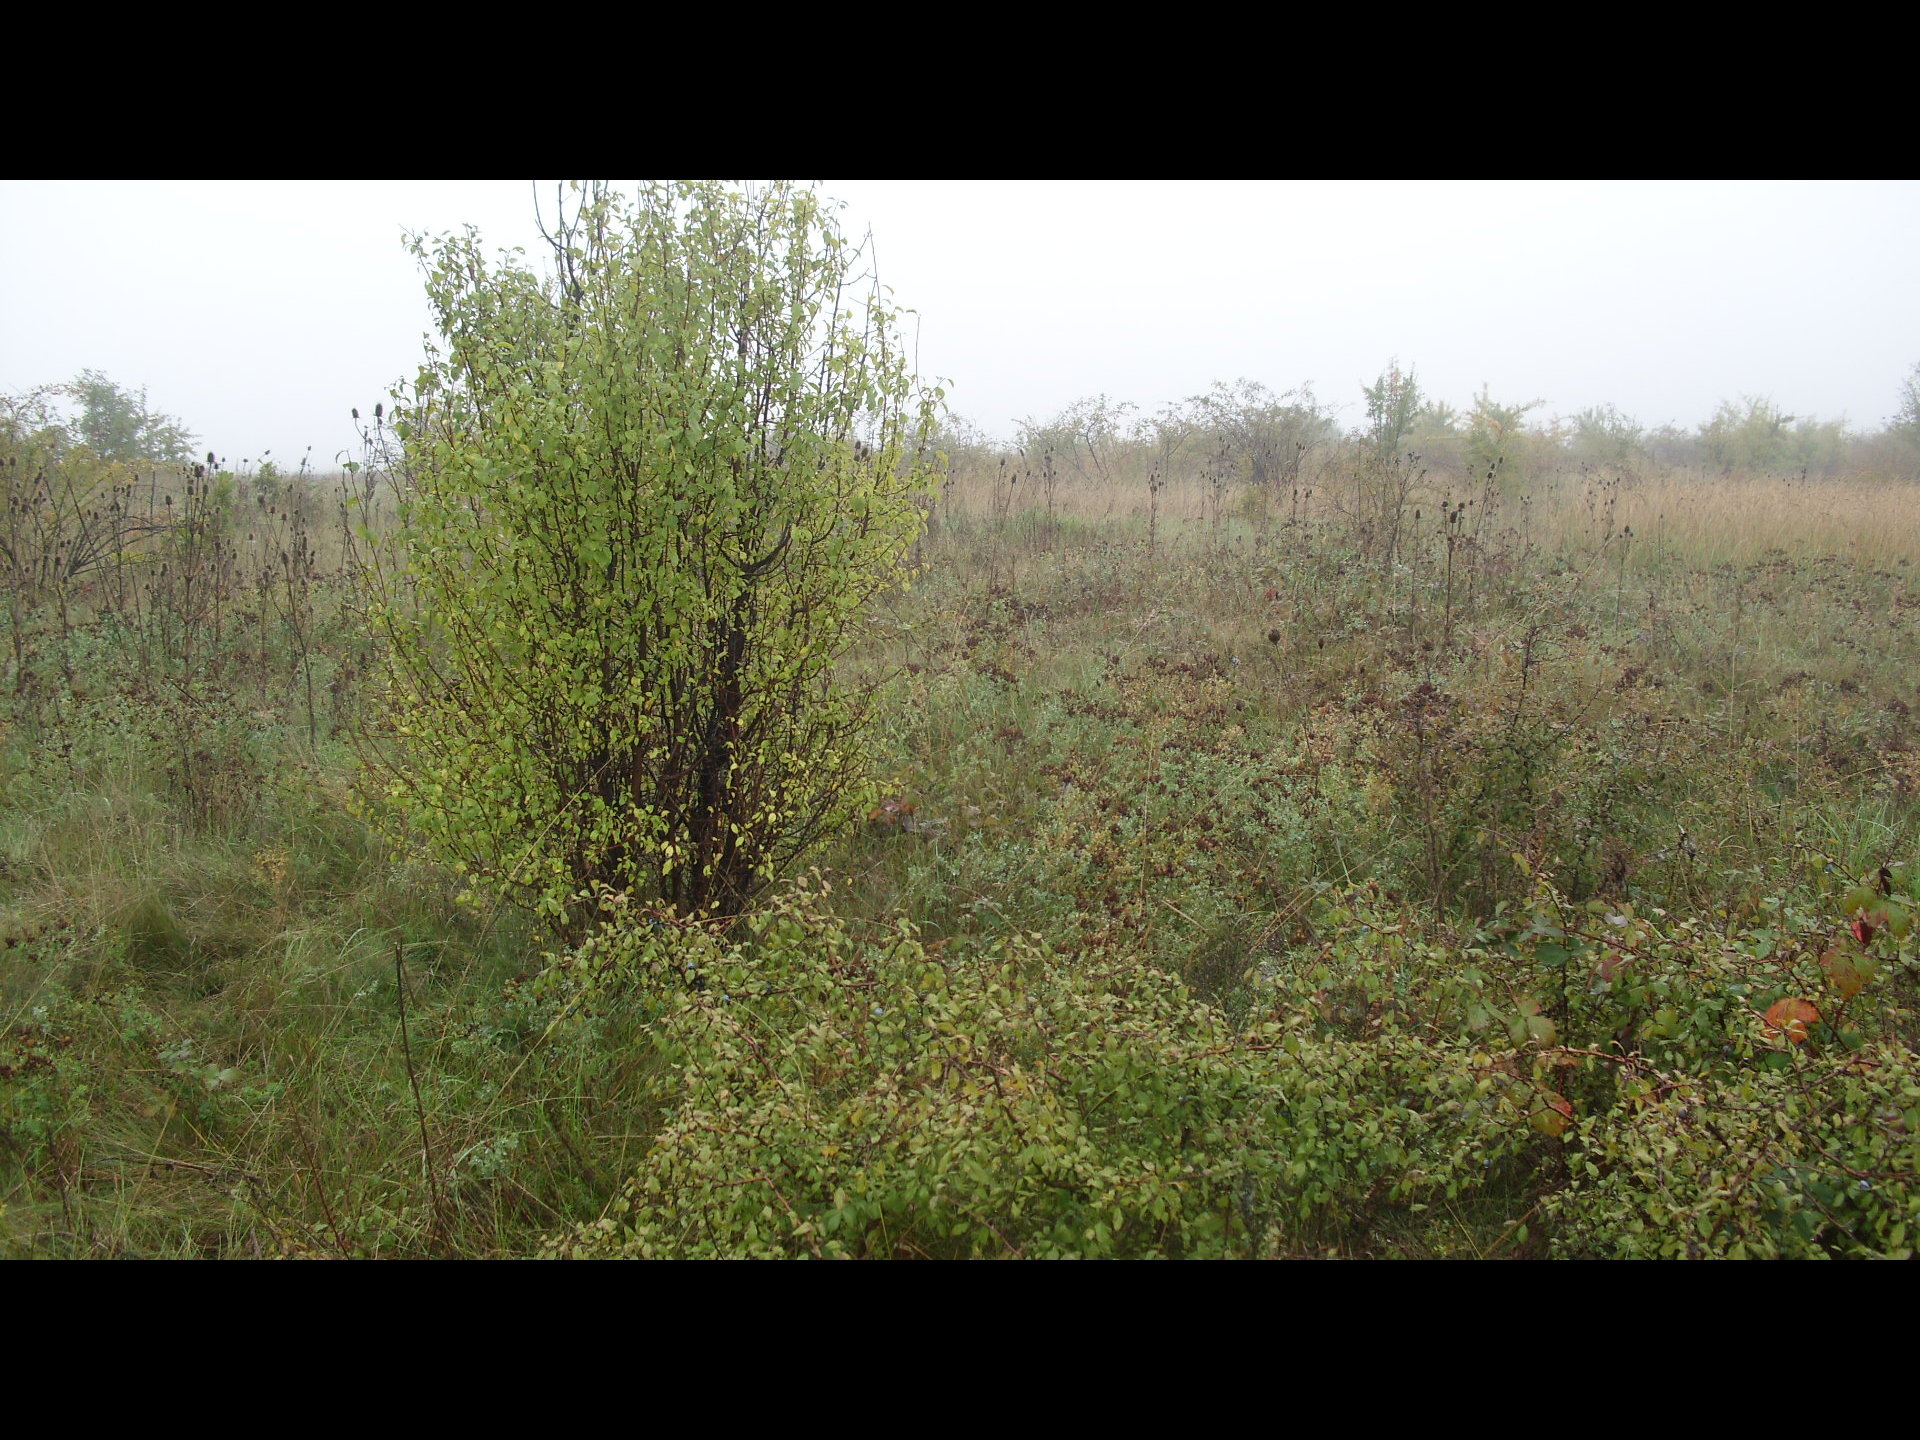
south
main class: Grassland
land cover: Grassland with sparse tree/shrub cover
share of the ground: > 75 %
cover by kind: herbaceous plants 85 %, shrubs 10 %, broadleaved forest trees 5 %
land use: Semi-natural and natural areas not in use
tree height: < 5 m
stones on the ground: < 10 %
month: October
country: BG
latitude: 43.7923
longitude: 22.4976
